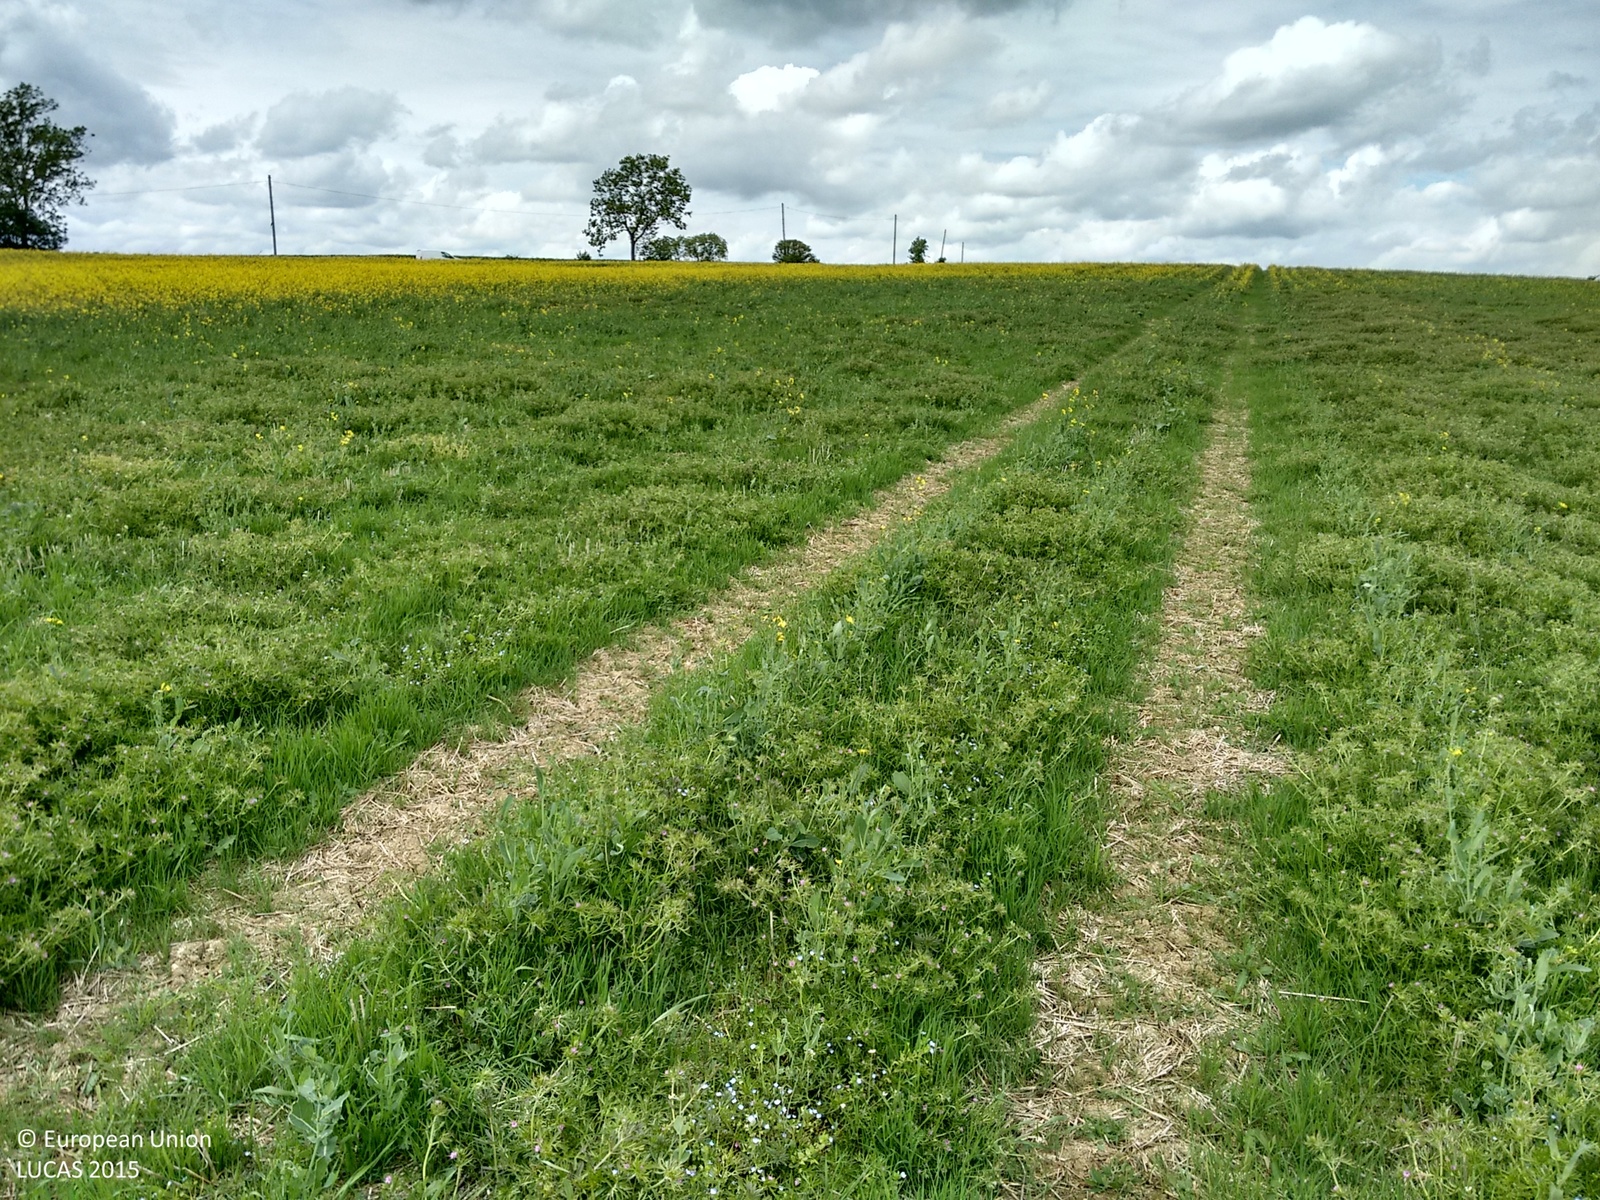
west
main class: Grassland
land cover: Spontaneously vegetated surfaces
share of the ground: > 75 %
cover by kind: herbaceous plants 100 %
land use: Fallow land
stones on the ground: < 10 %
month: June
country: GB
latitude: 52.2362
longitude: -0.5082
